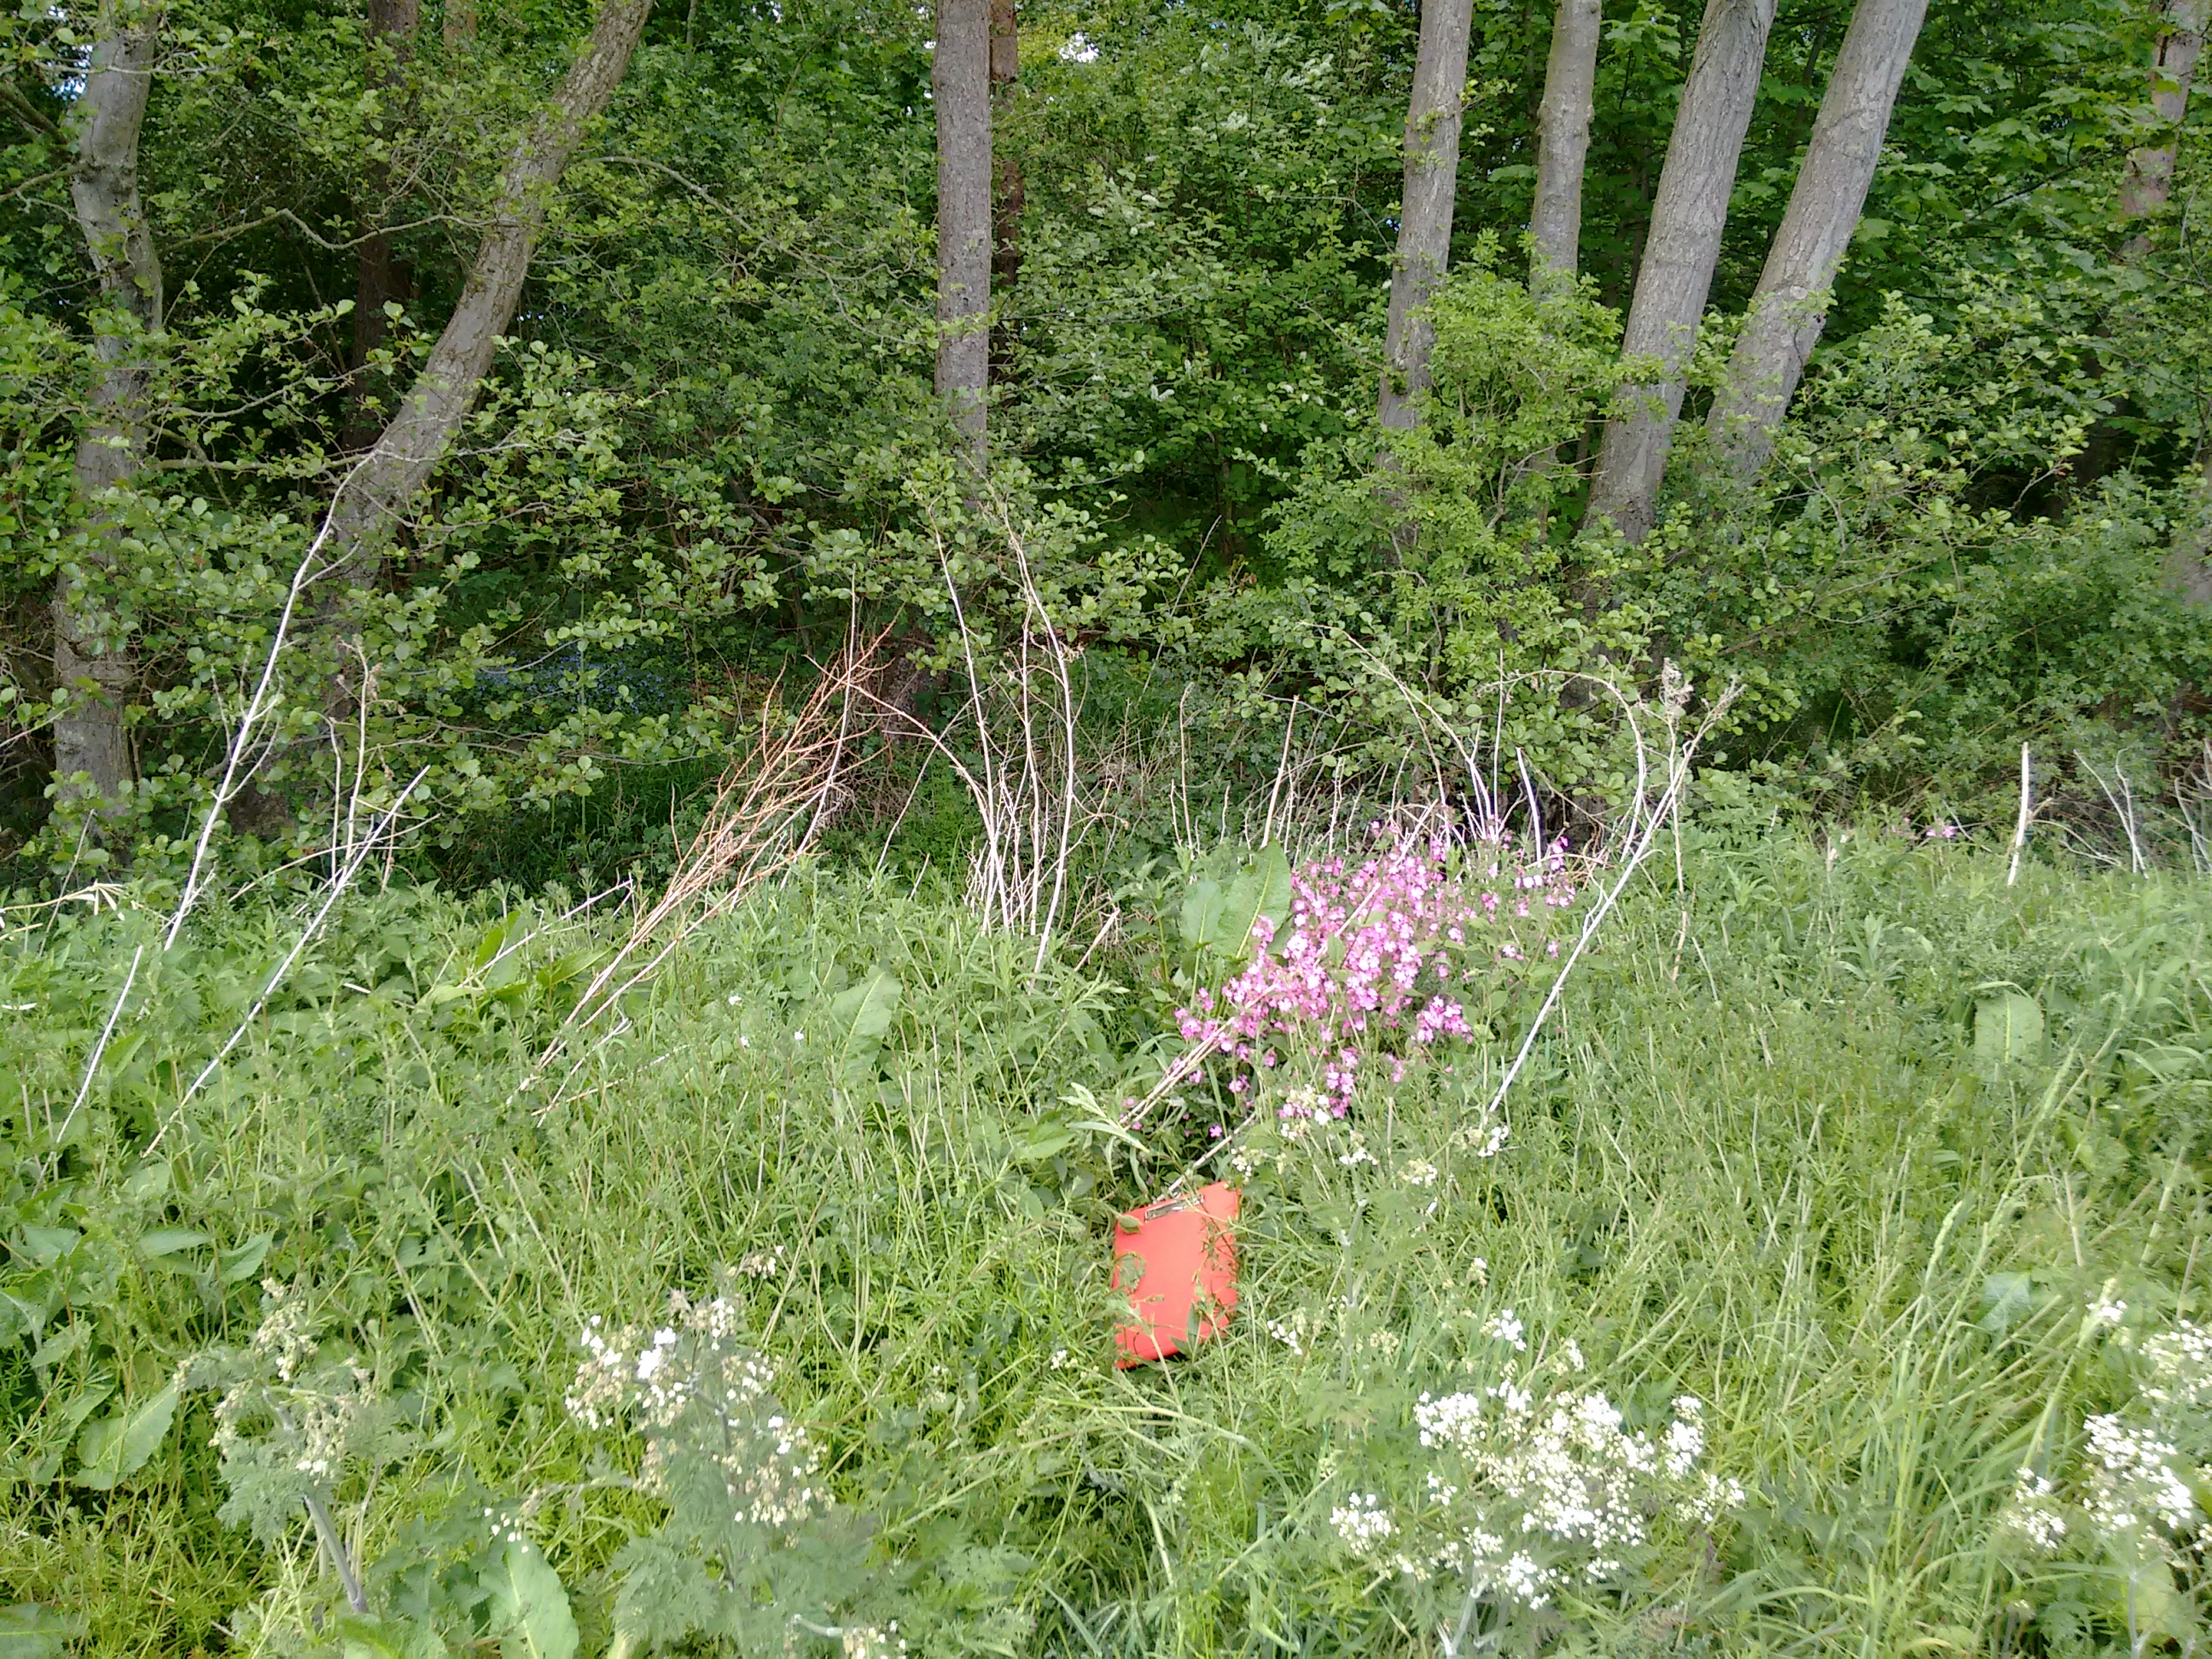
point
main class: Grassland
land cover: Grassland without tree/shrub cover
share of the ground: 50 - 75 %
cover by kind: herbaceous plants 100 %
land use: Agriculture (excluding fallow land and kitchen gardens)
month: May
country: GB
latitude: 55.9146
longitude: -2.9142
